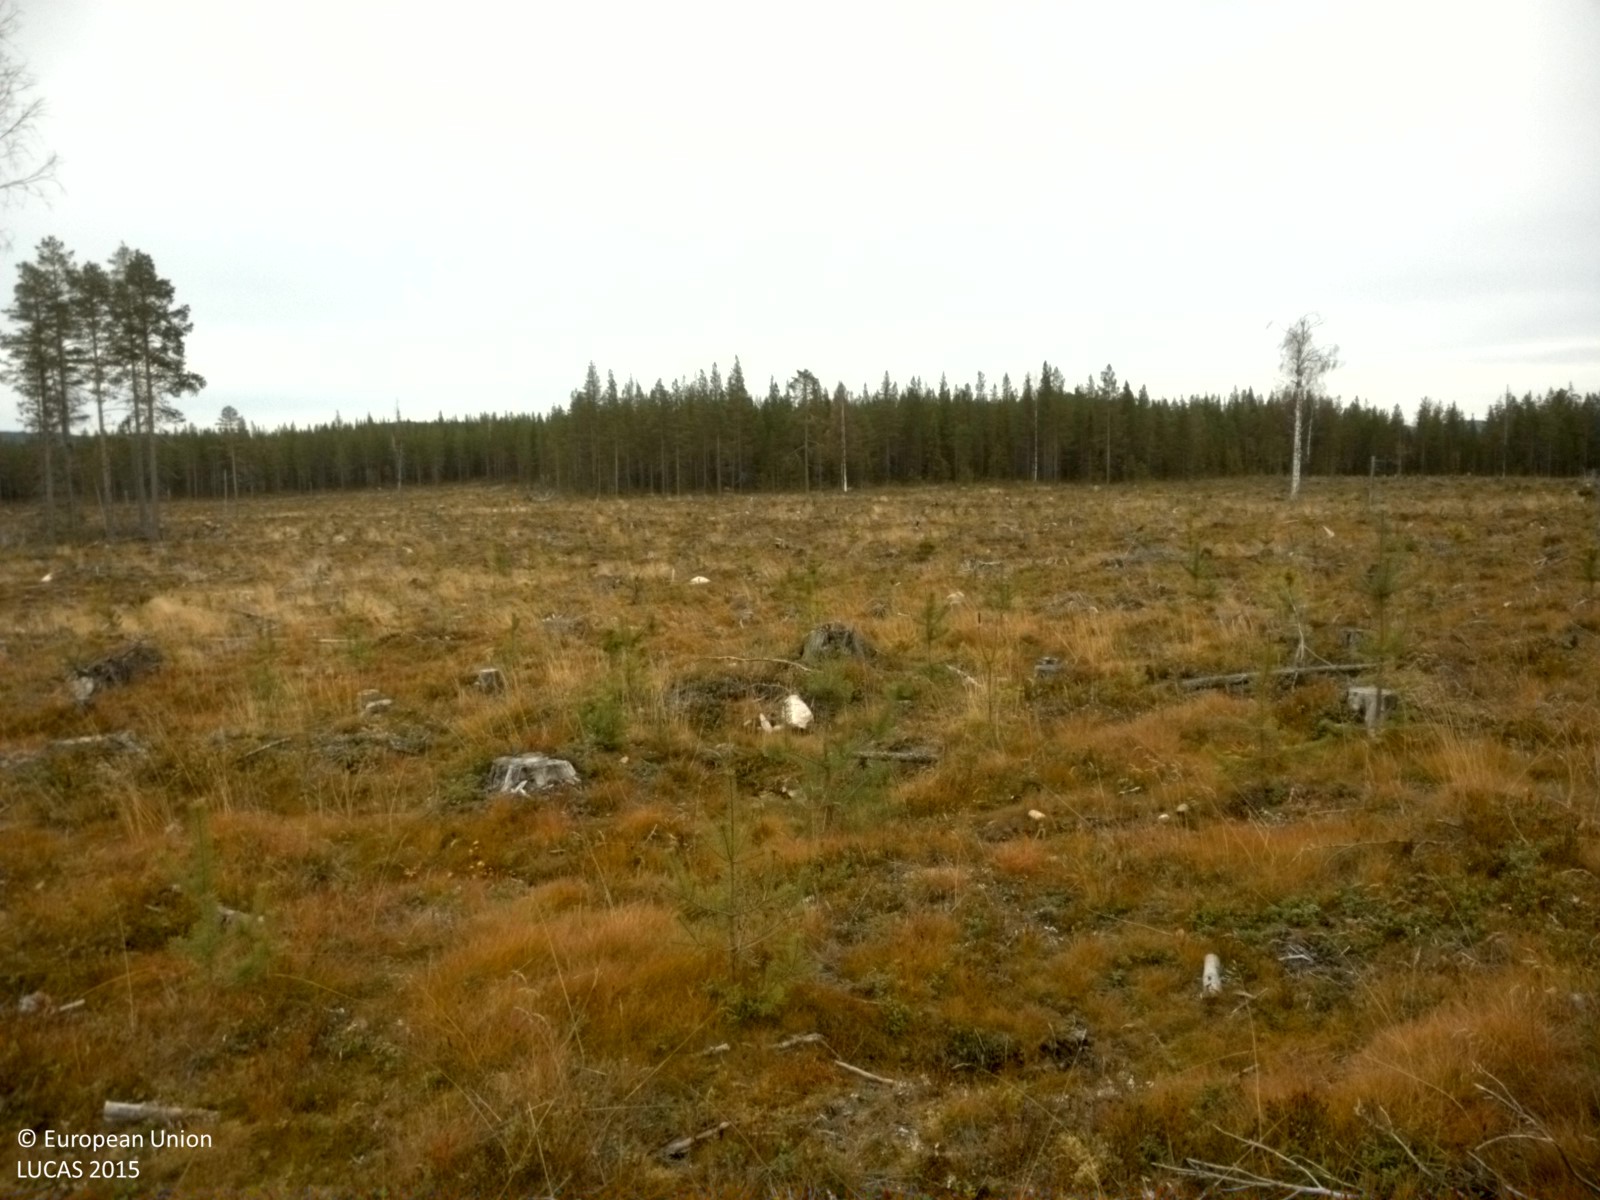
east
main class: Shrubland
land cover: Shrubland with sparse tree cover
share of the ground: 50 - 75 %
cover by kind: shrubs 50 %, herbaceous plants 40 %, coniferous forest trees 5 %, lichens and mosses 5 %
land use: Forestry
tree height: < 5 m
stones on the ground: 10 - 25 %
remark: Clear cut
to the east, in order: Shrubland with sparse tree cover; Pine dominated coniferous woodland
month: October
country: SE
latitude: 65.7305
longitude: 20.1888
